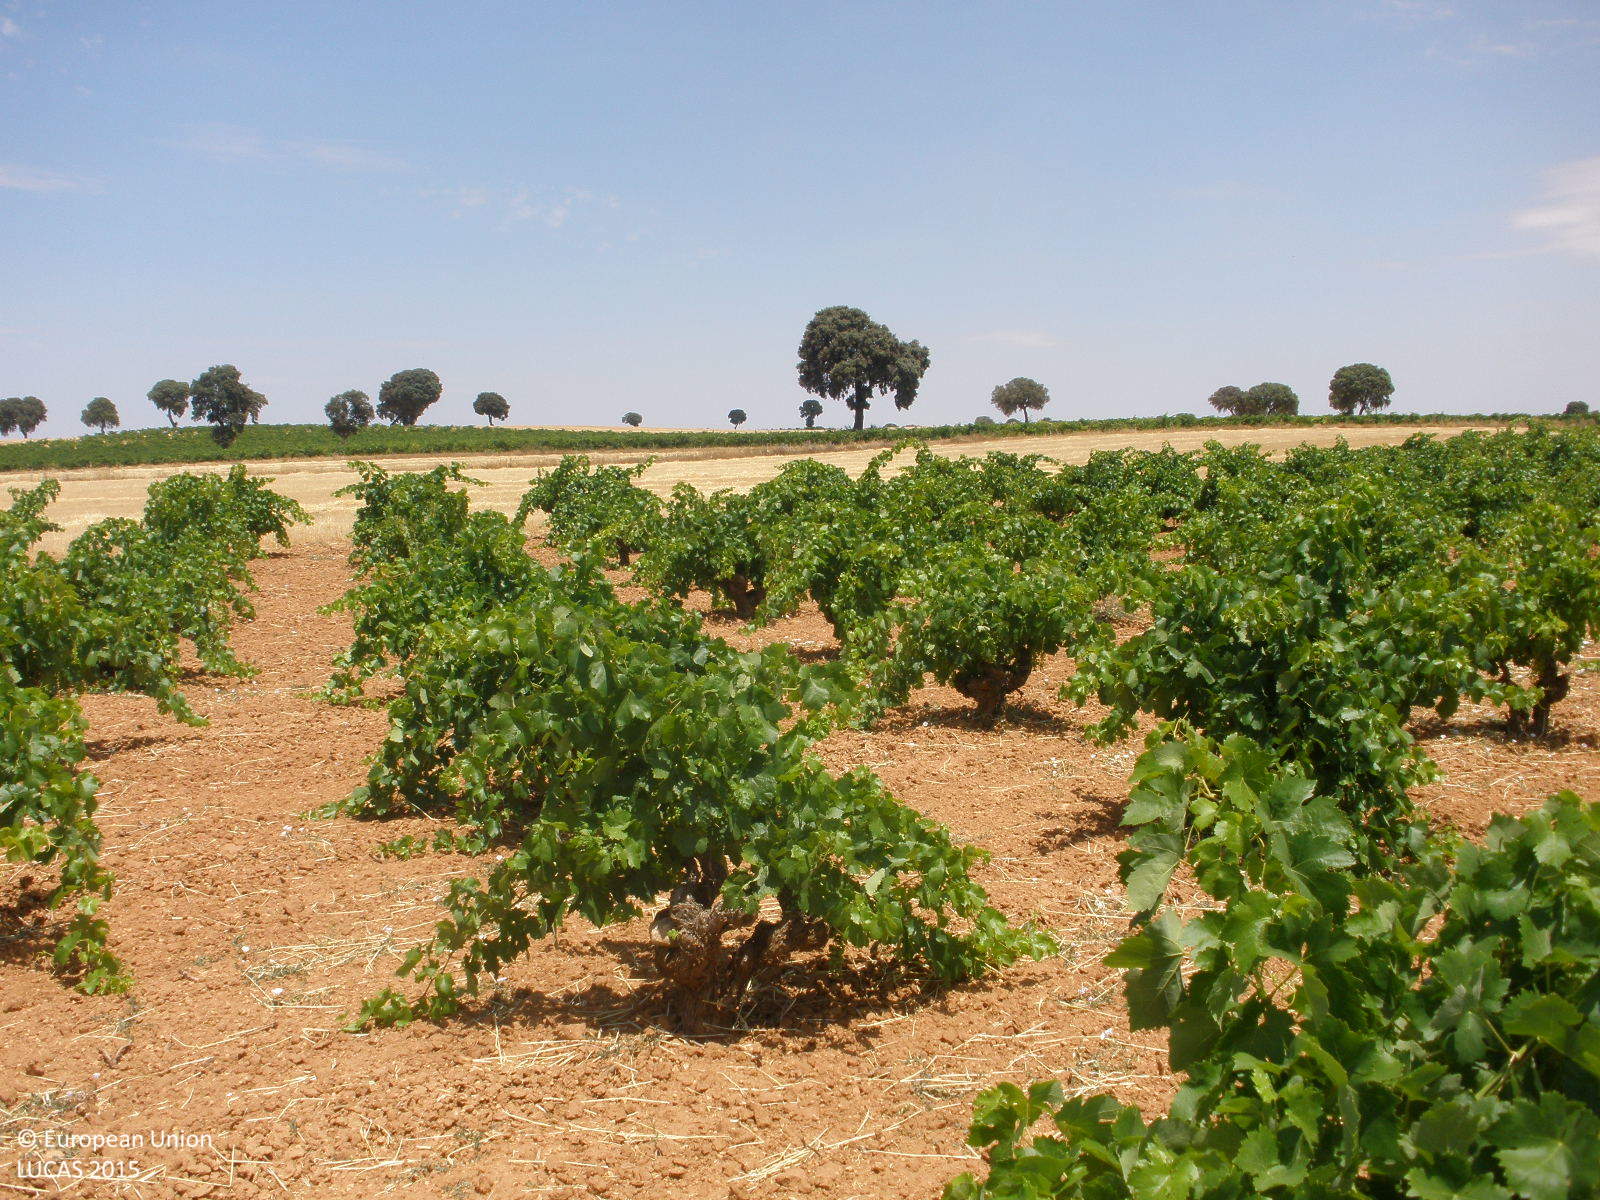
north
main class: Cropland
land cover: Vineyards
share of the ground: 50 - 75 %
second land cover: Other bare soil
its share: > 75 %
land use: Agriculture (excluding fallow land and kitchen gardens)
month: July
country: ES
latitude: 39.8980
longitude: -3.2295
